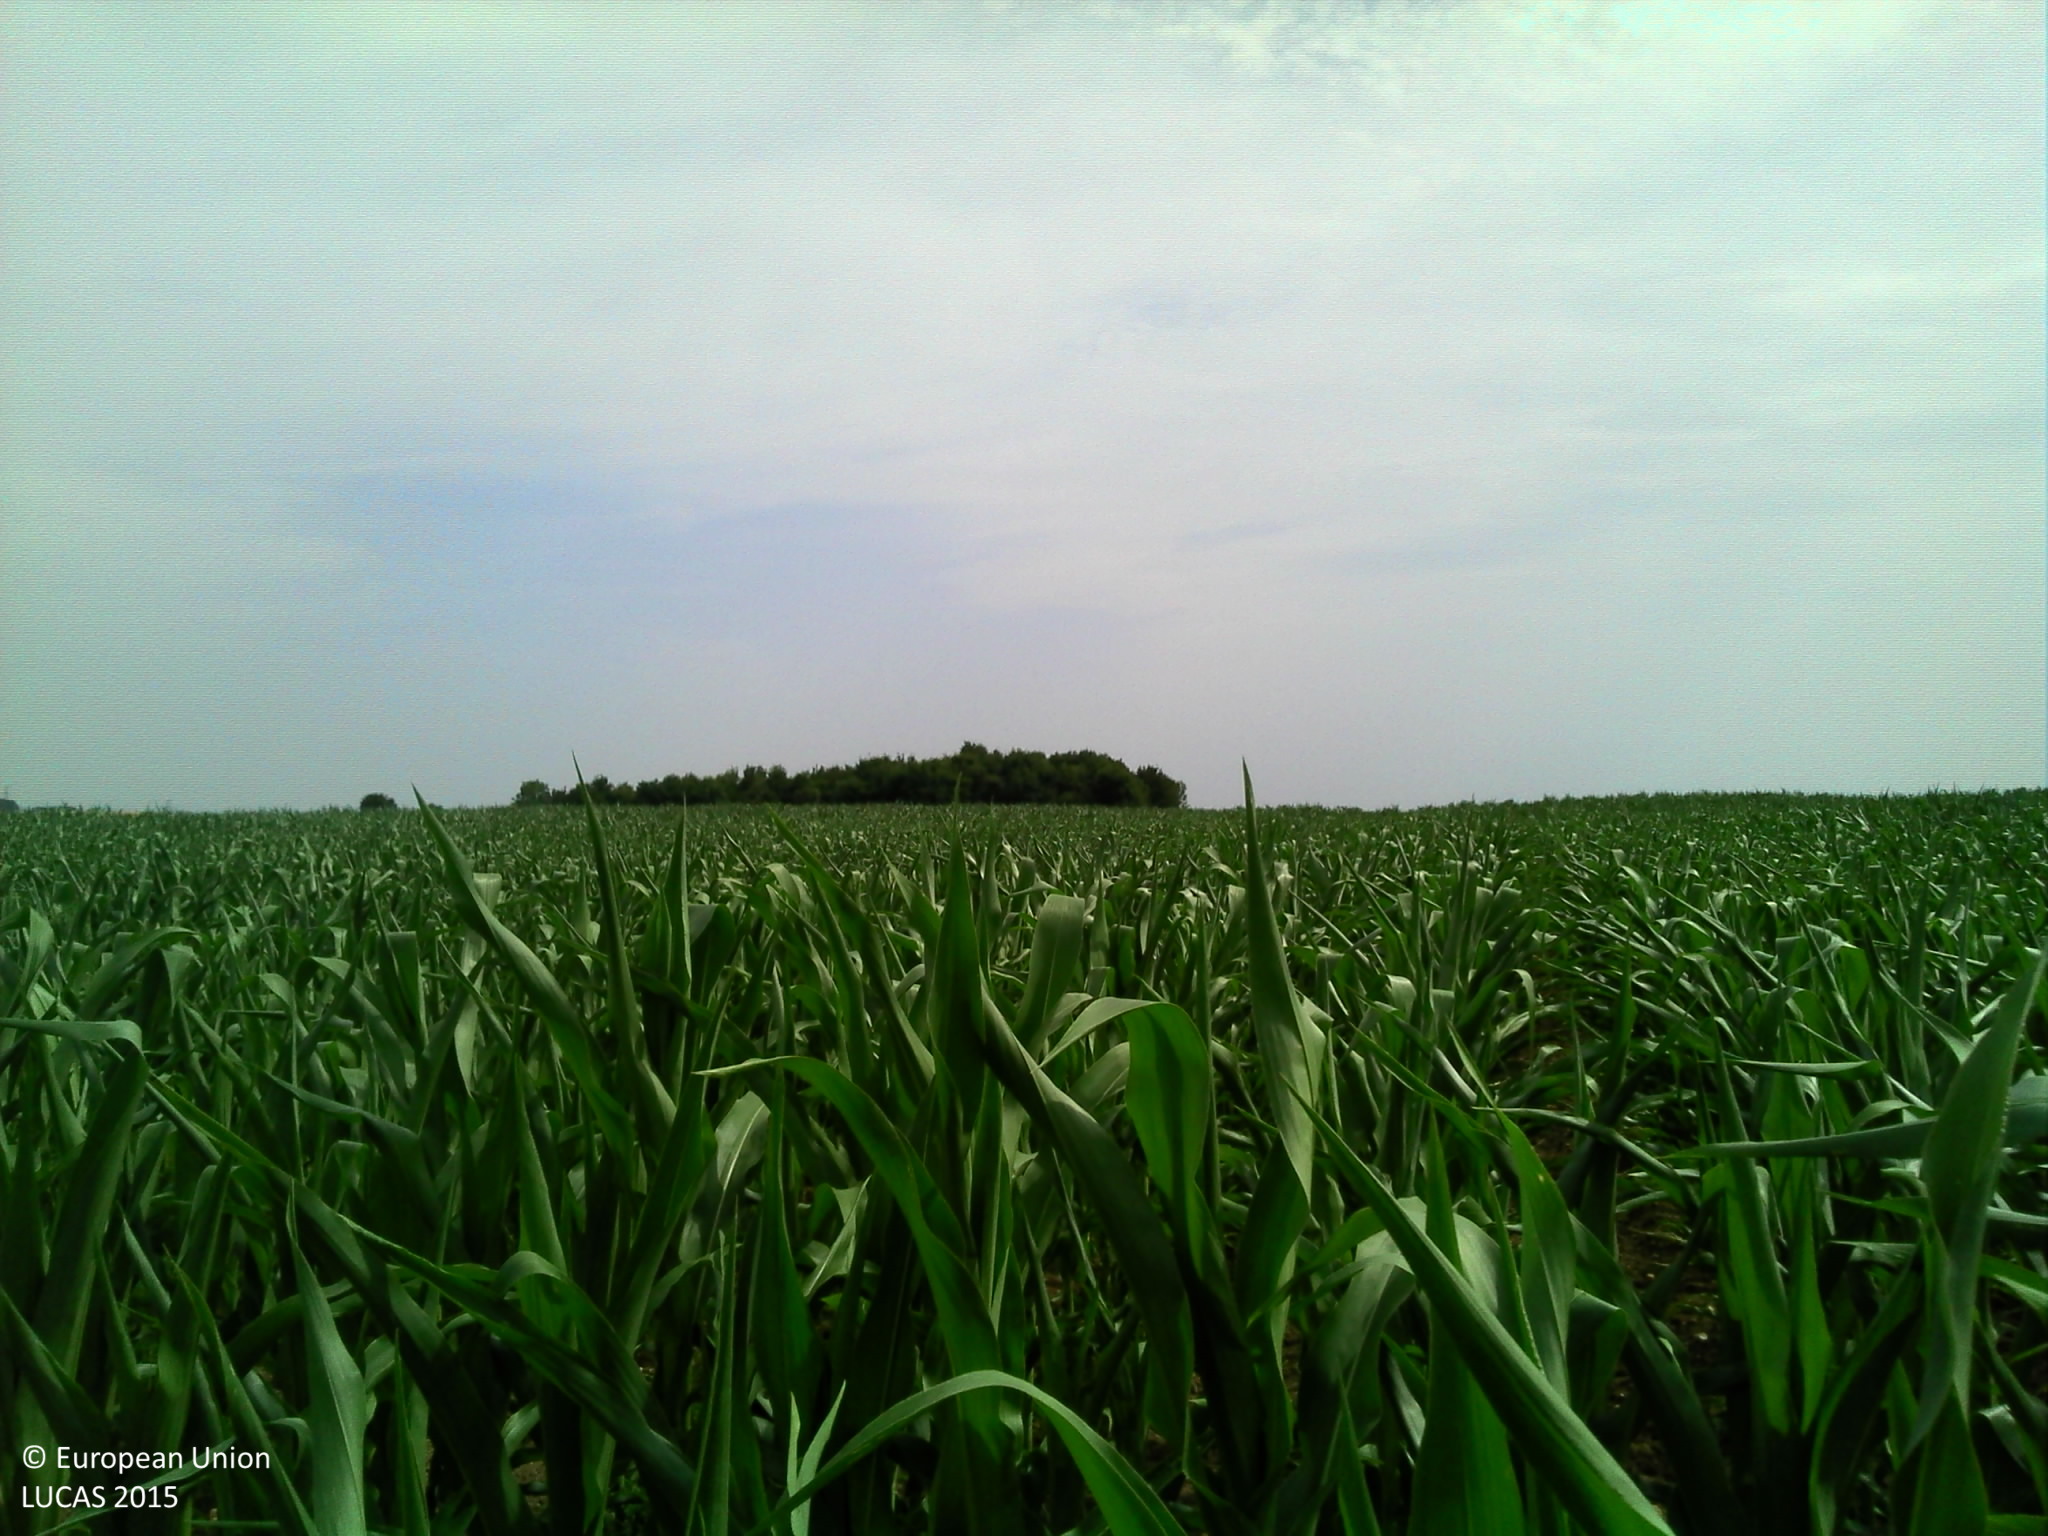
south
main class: Cropland
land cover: Maize
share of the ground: > 75 %
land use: Agriculture (excluding fallow land and kitchen gardens)
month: July
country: FR
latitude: 46.1578
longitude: 3.2785
